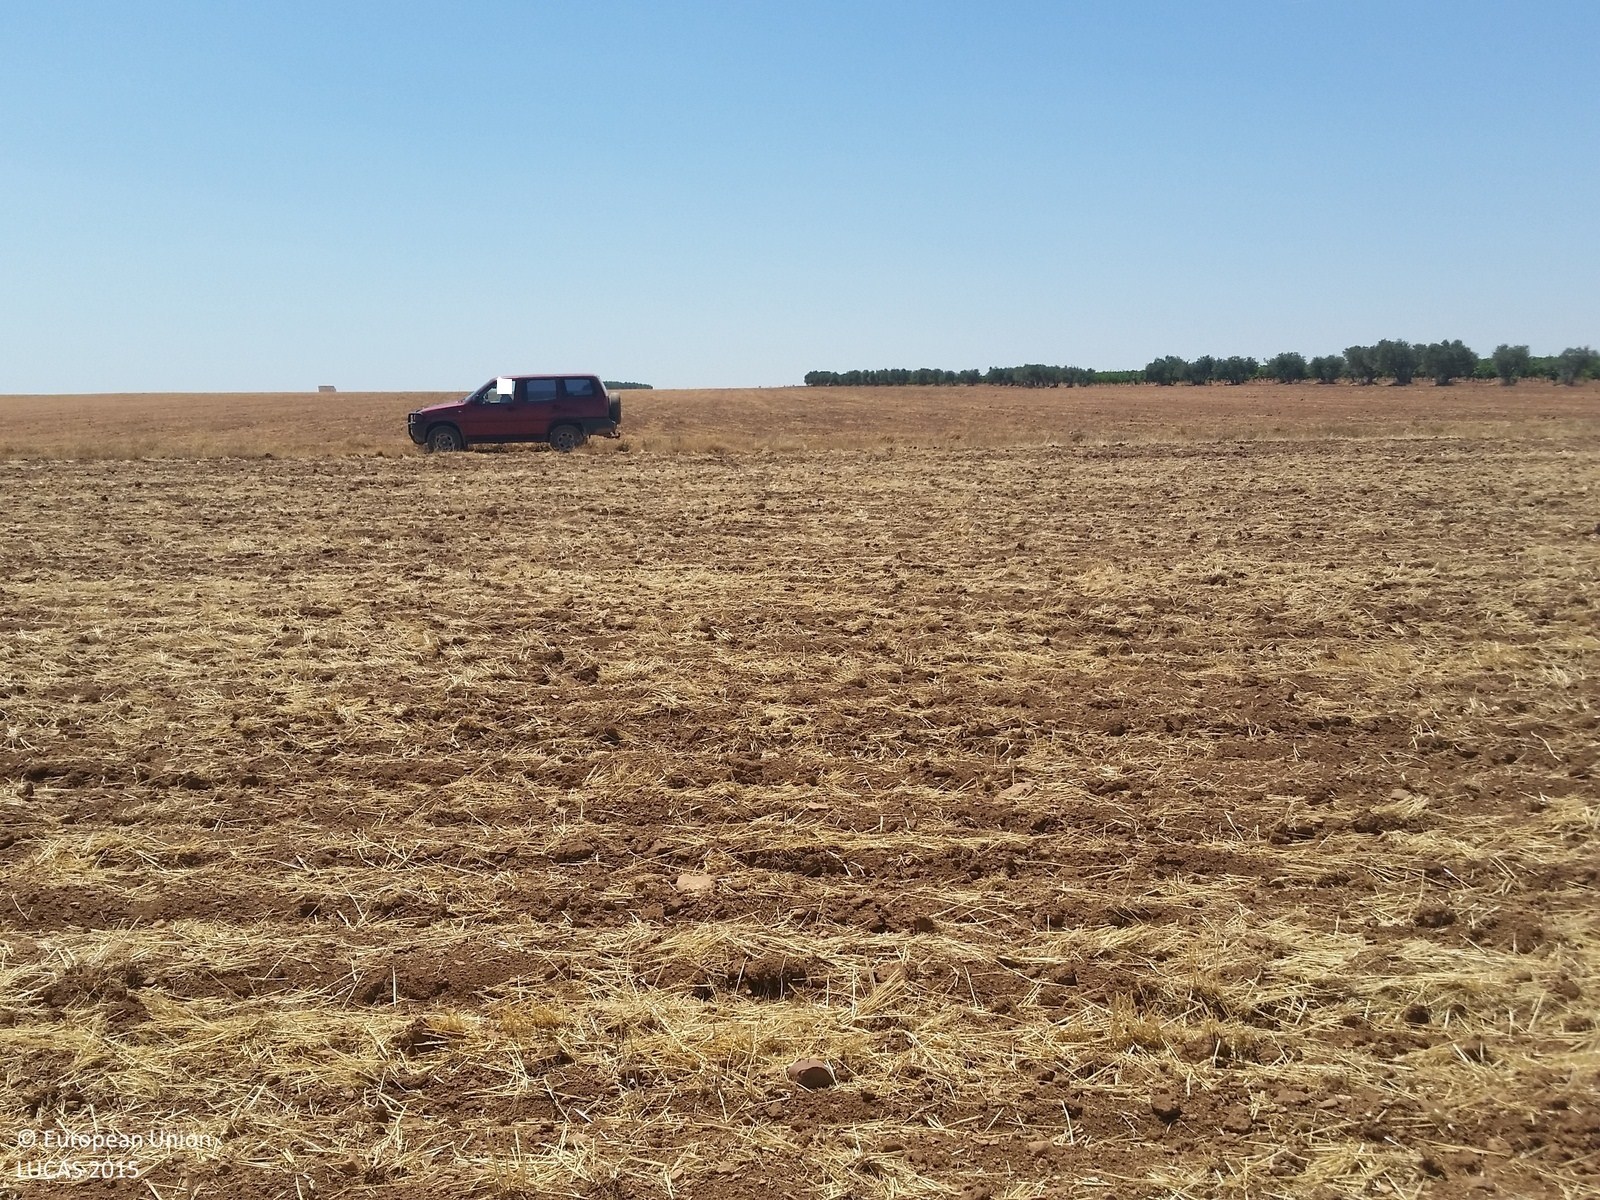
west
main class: Cropland
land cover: Barley
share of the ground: < 10 %
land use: Agriculture (excluding fallow land and kitchen gardens)
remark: Harvested field
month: July
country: ES
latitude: 39.1633
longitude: -2.5654
